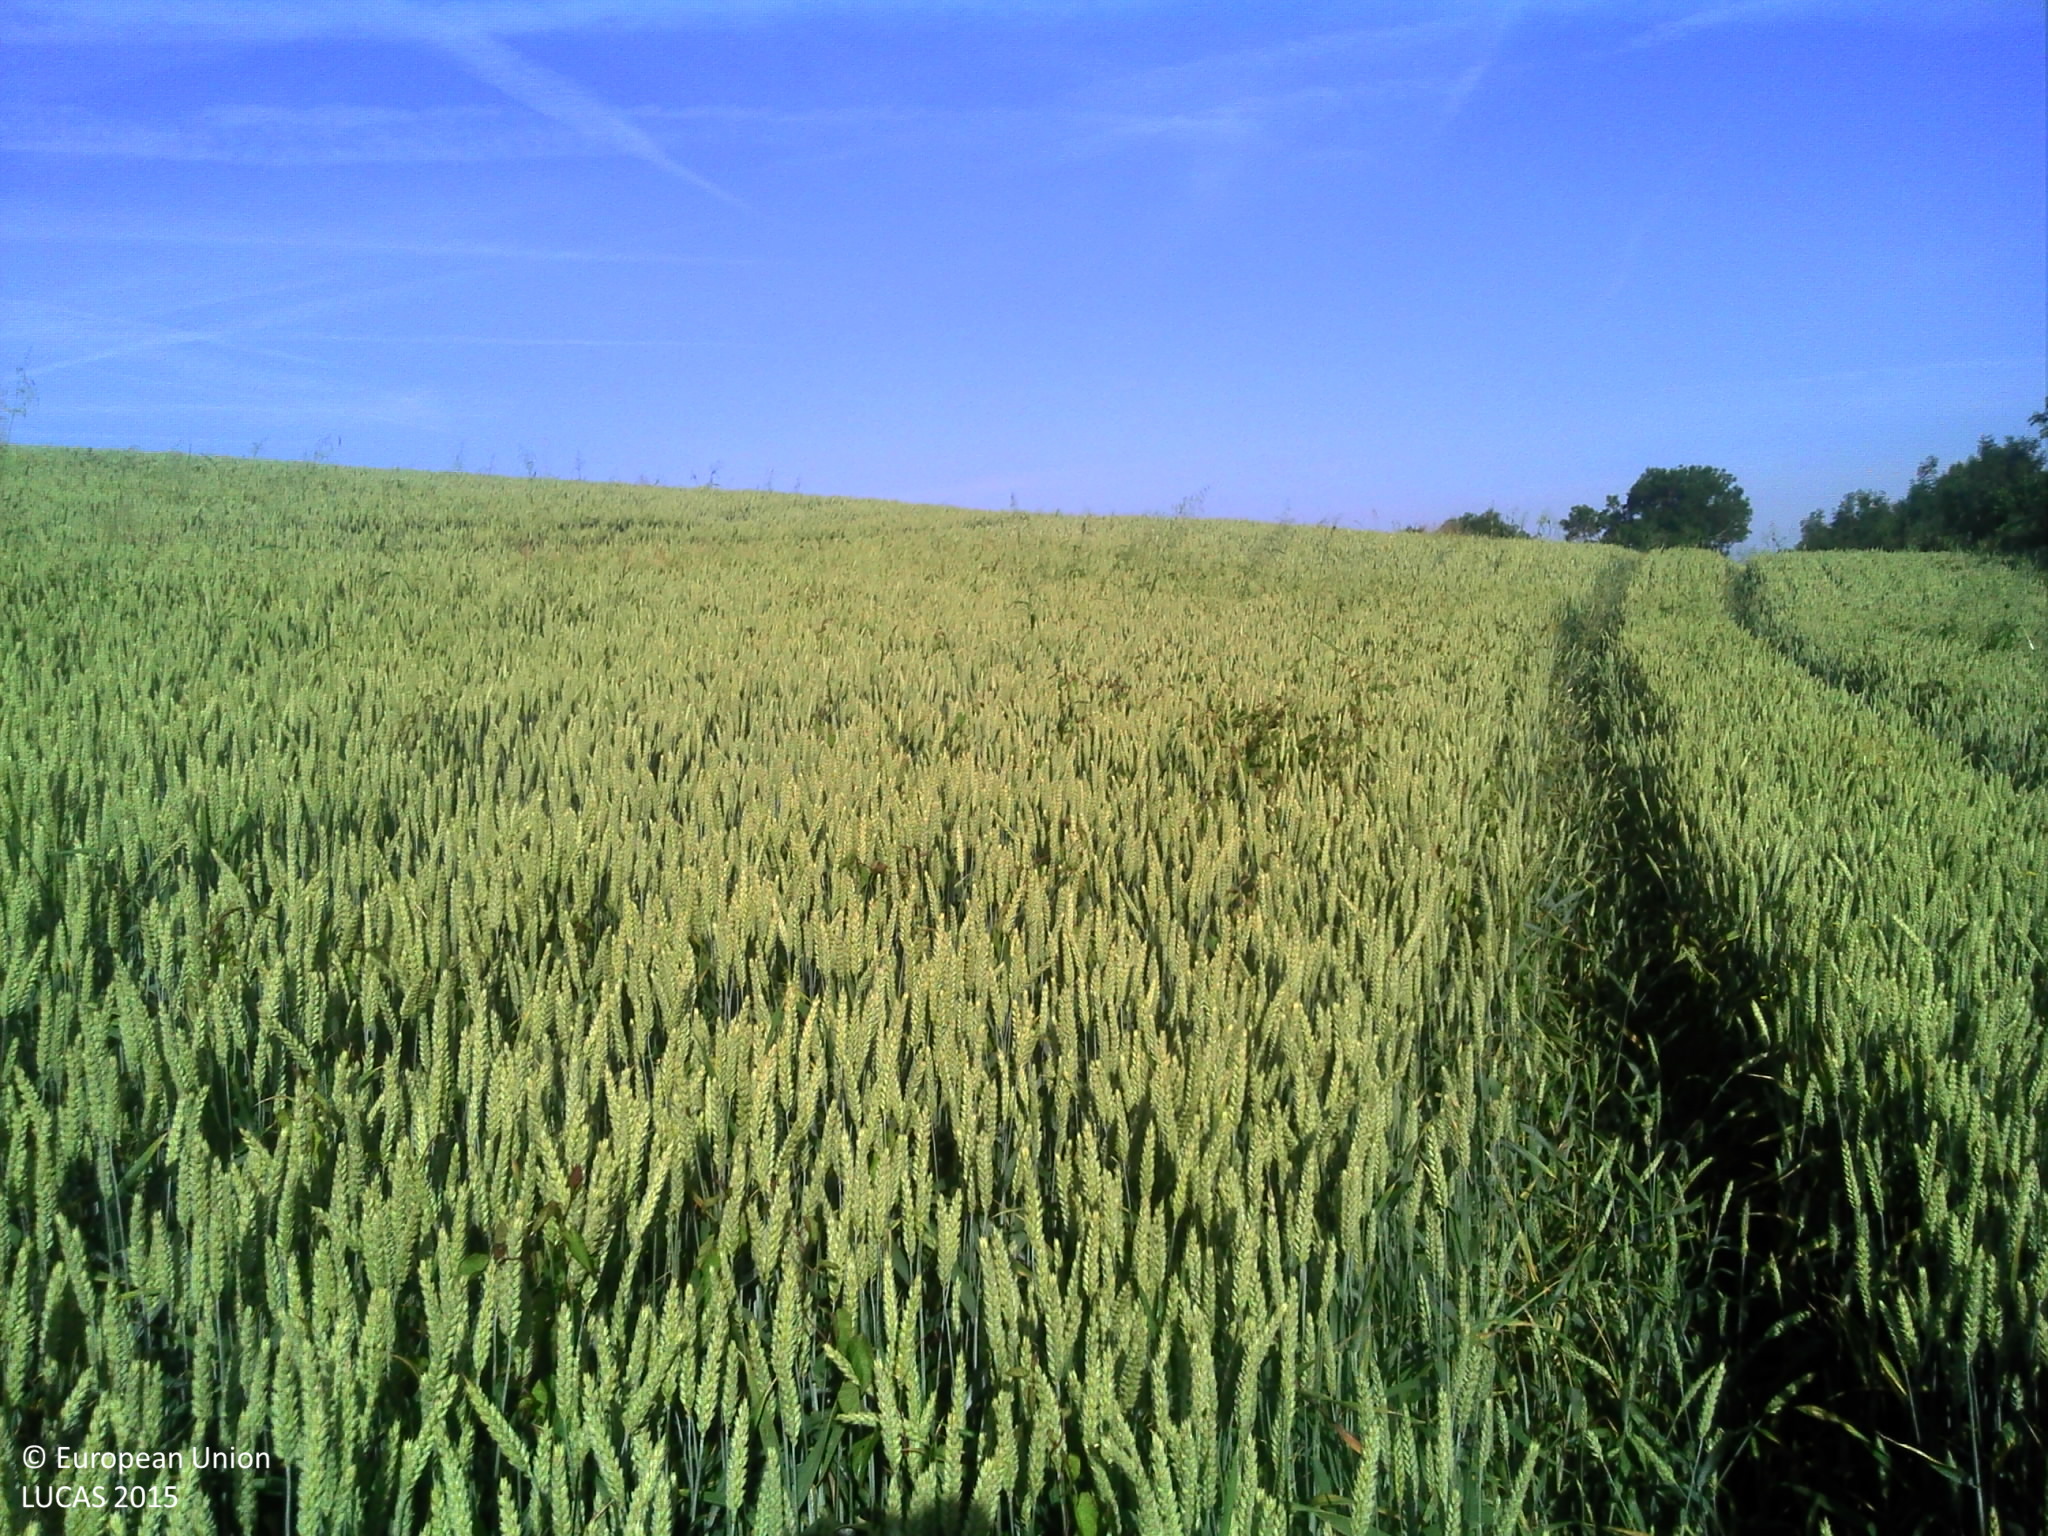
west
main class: Cropland
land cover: Common wheat
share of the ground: > 75 %
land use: Agriculture (excluding fallow land and kitchen gardens)
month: June
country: FR
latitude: 49.3301
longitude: -1.6511
